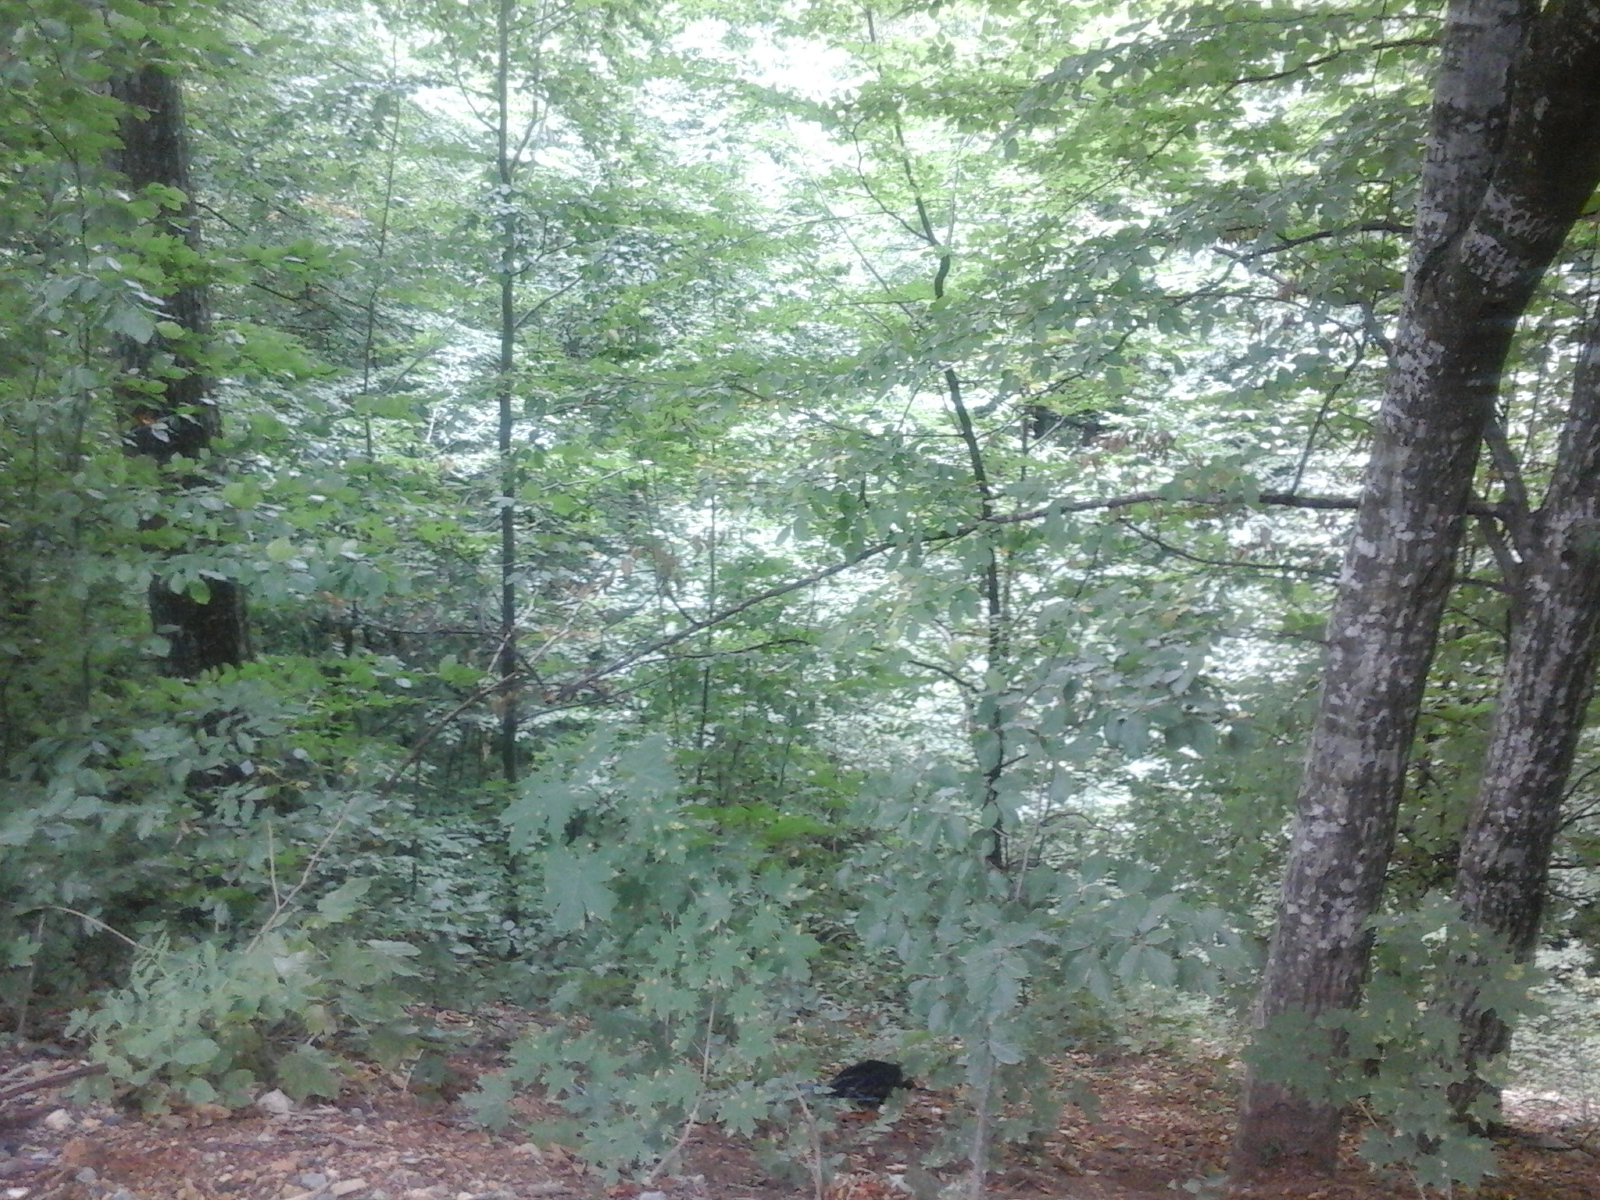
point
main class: Woodland
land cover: Broadleaved woodland
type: beech forest
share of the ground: > 75 %
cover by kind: broadleaved forest trees 100 %
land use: Forestry
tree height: > 5 m
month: August
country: RO
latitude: 45.1056
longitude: 21.8666
